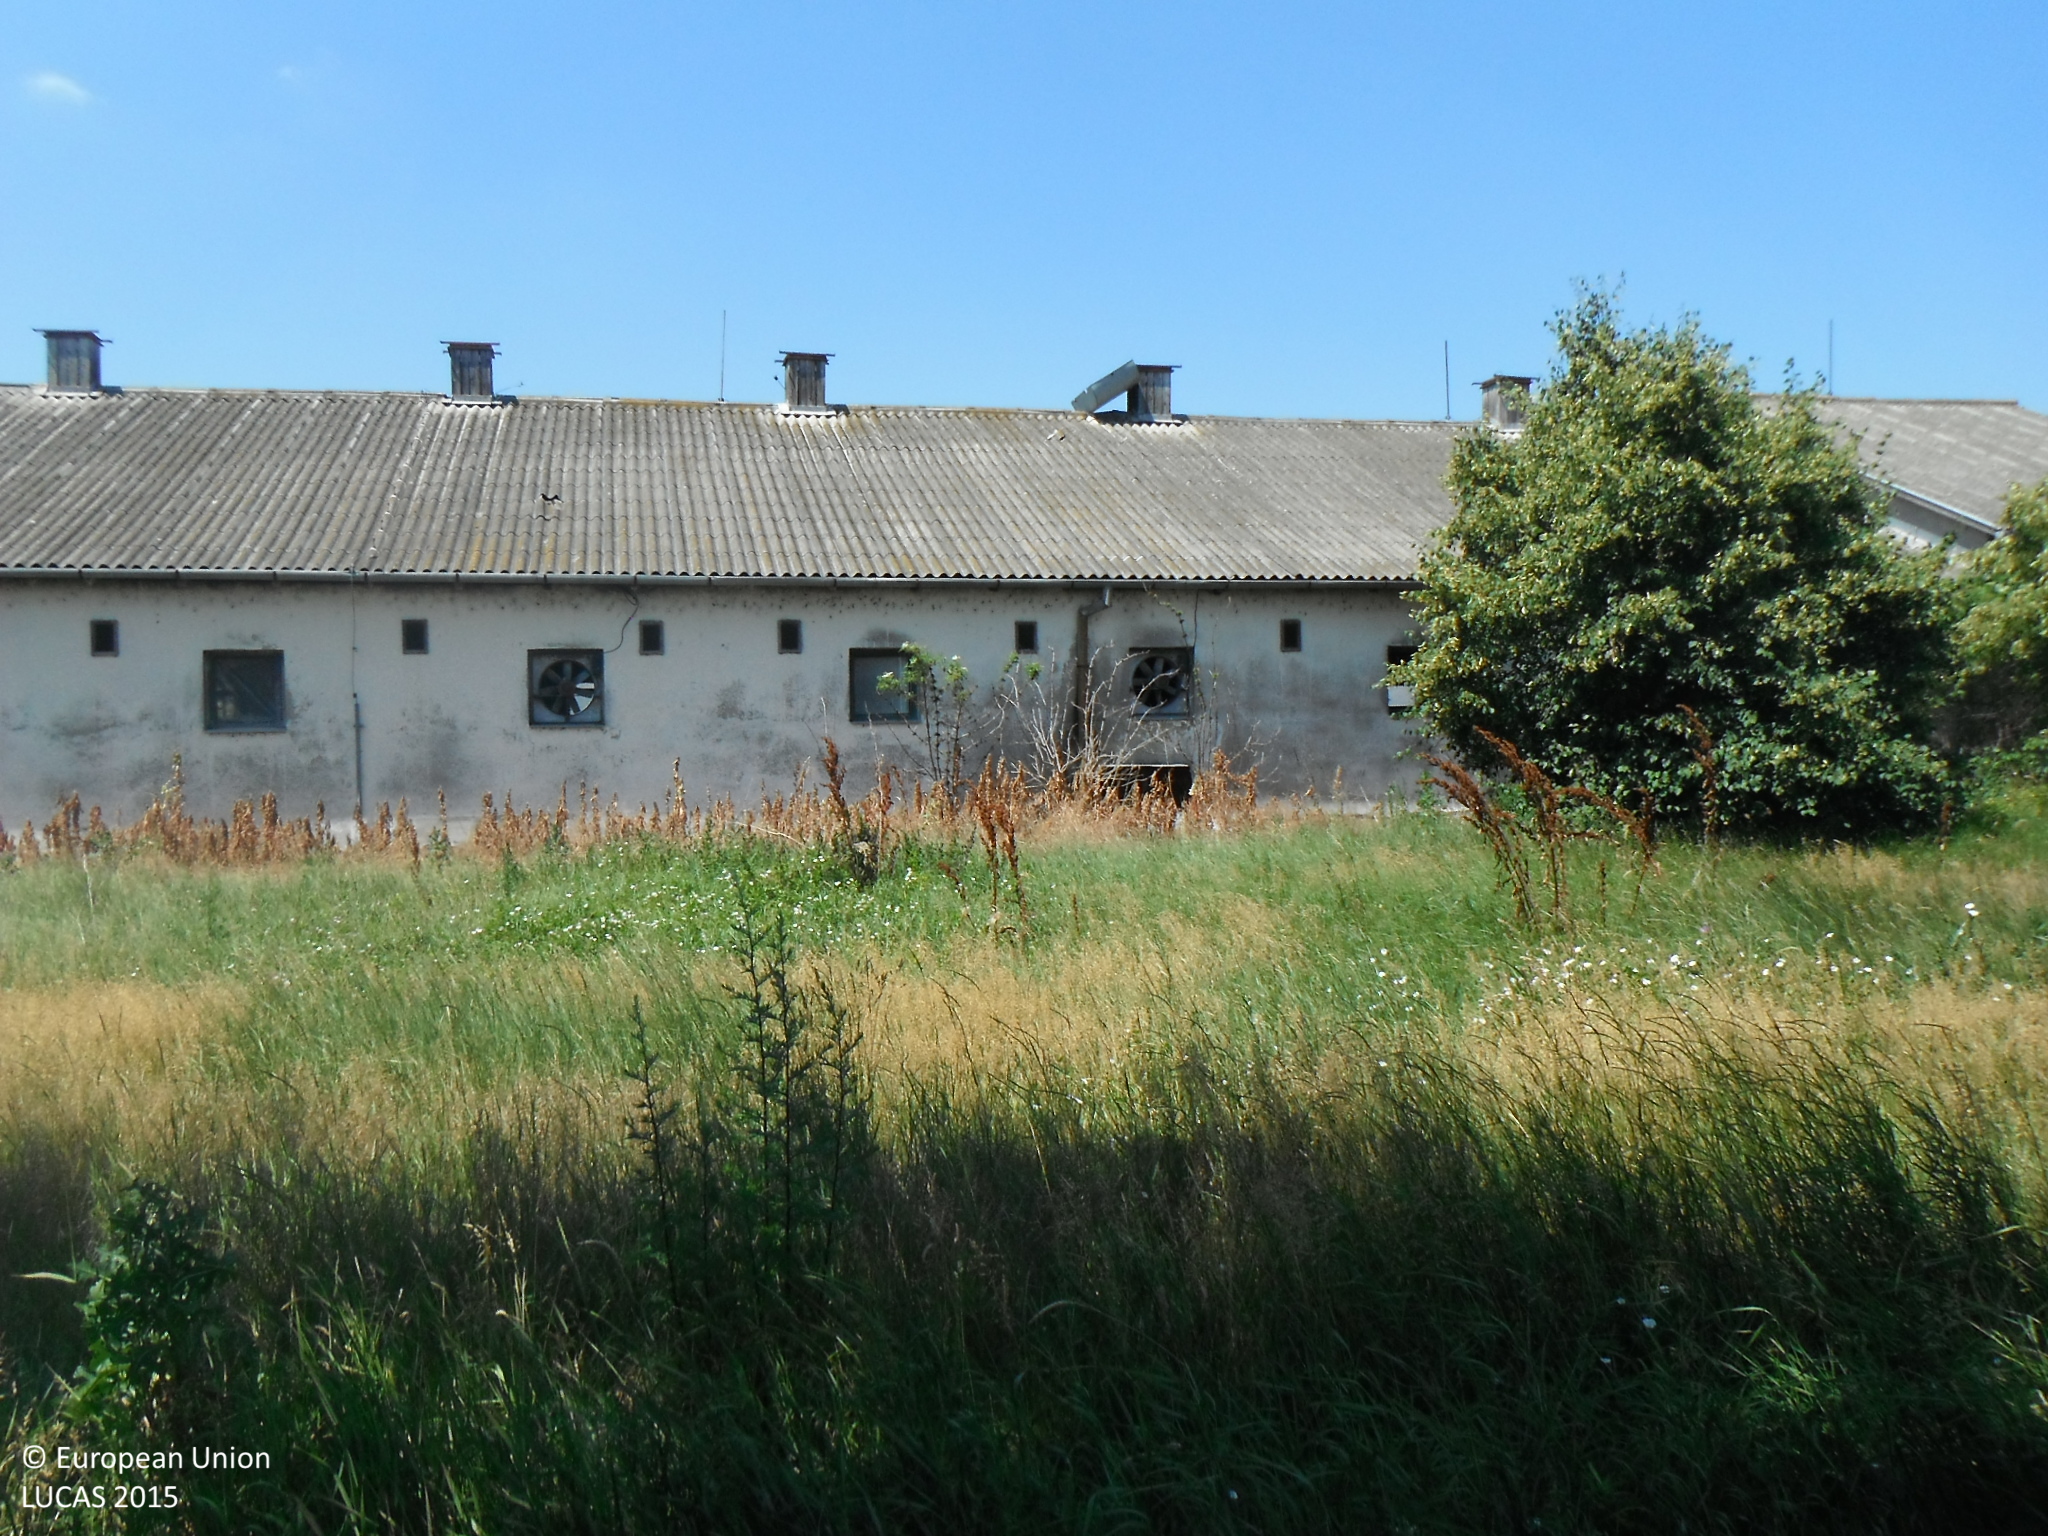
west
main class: Grassland
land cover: Spontaneously vegetated surfaces
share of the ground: > 75 %
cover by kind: herbaceous plants 100 %
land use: Abandoned areas
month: June
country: SK
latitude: 47.8470
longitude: 18.1778
